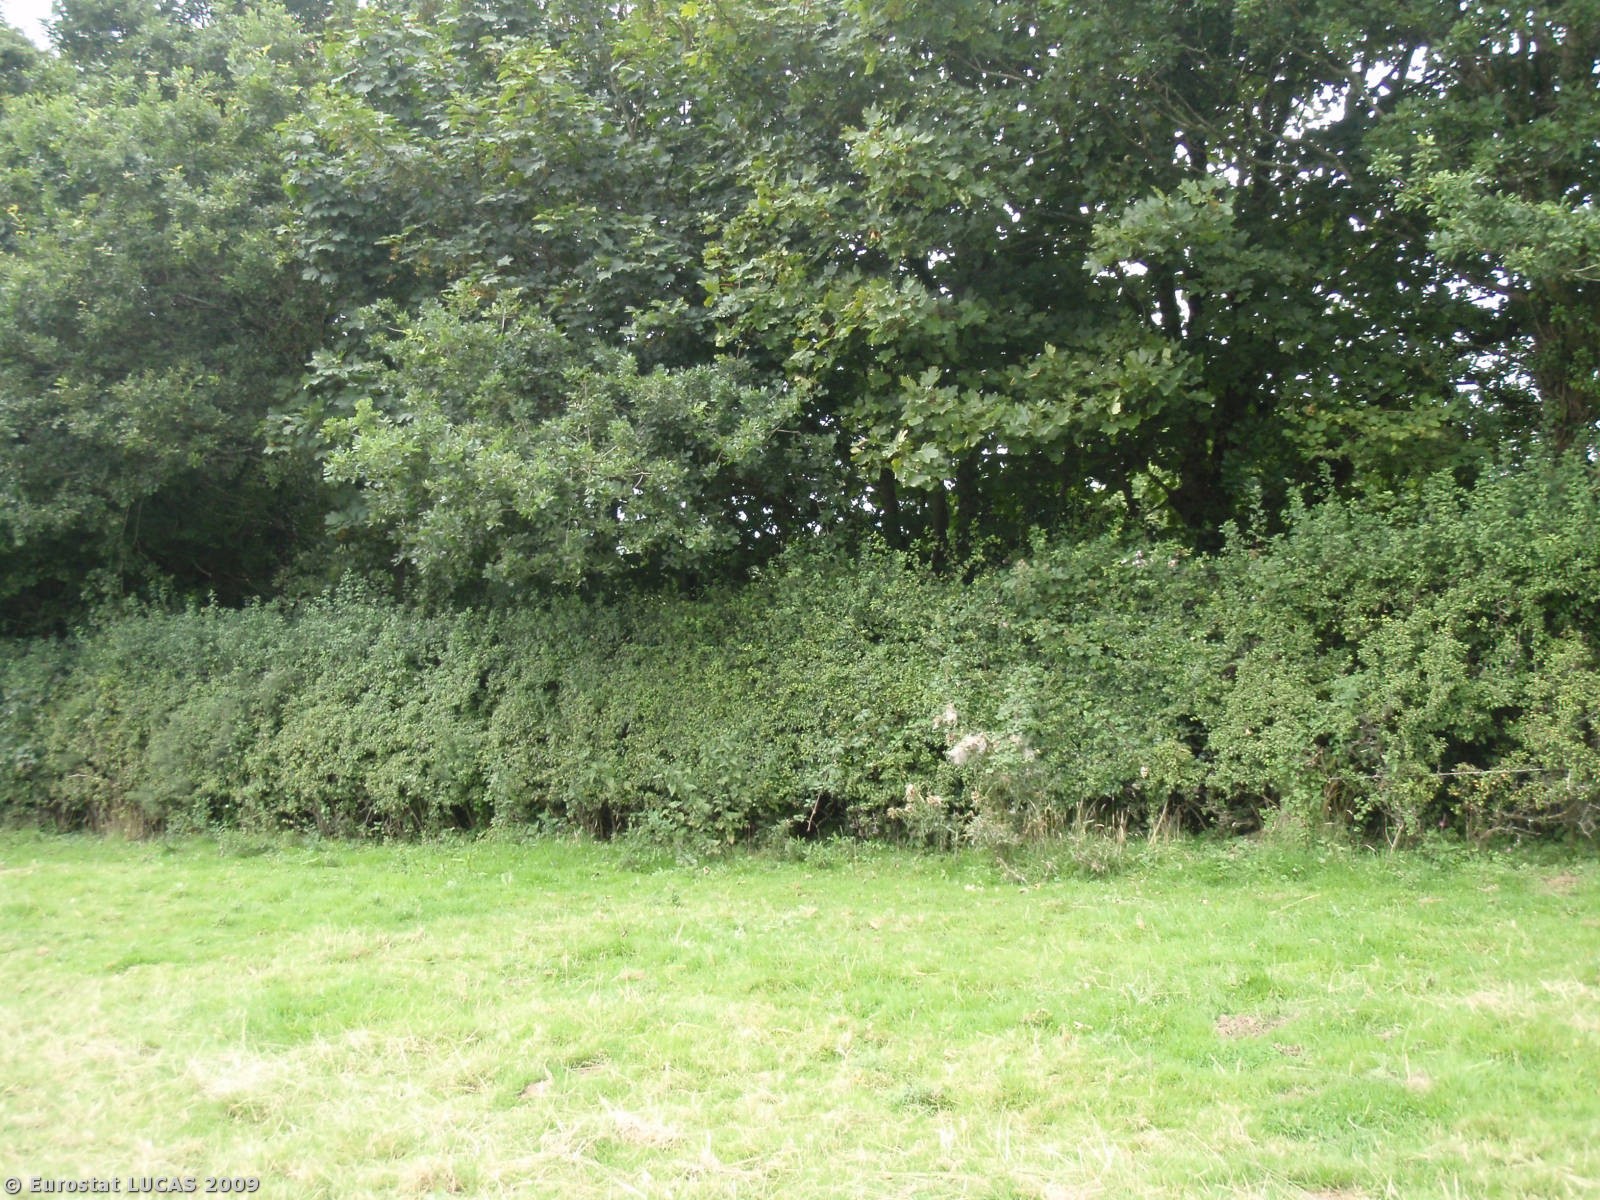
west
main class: Grassland
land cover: Grassland without tree/shrub cover
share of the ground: > 75 %
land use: Agriculture (excluding fallow land and kitchen gardens)
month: August
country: GB
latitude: 50.5714
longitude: -4.3190
